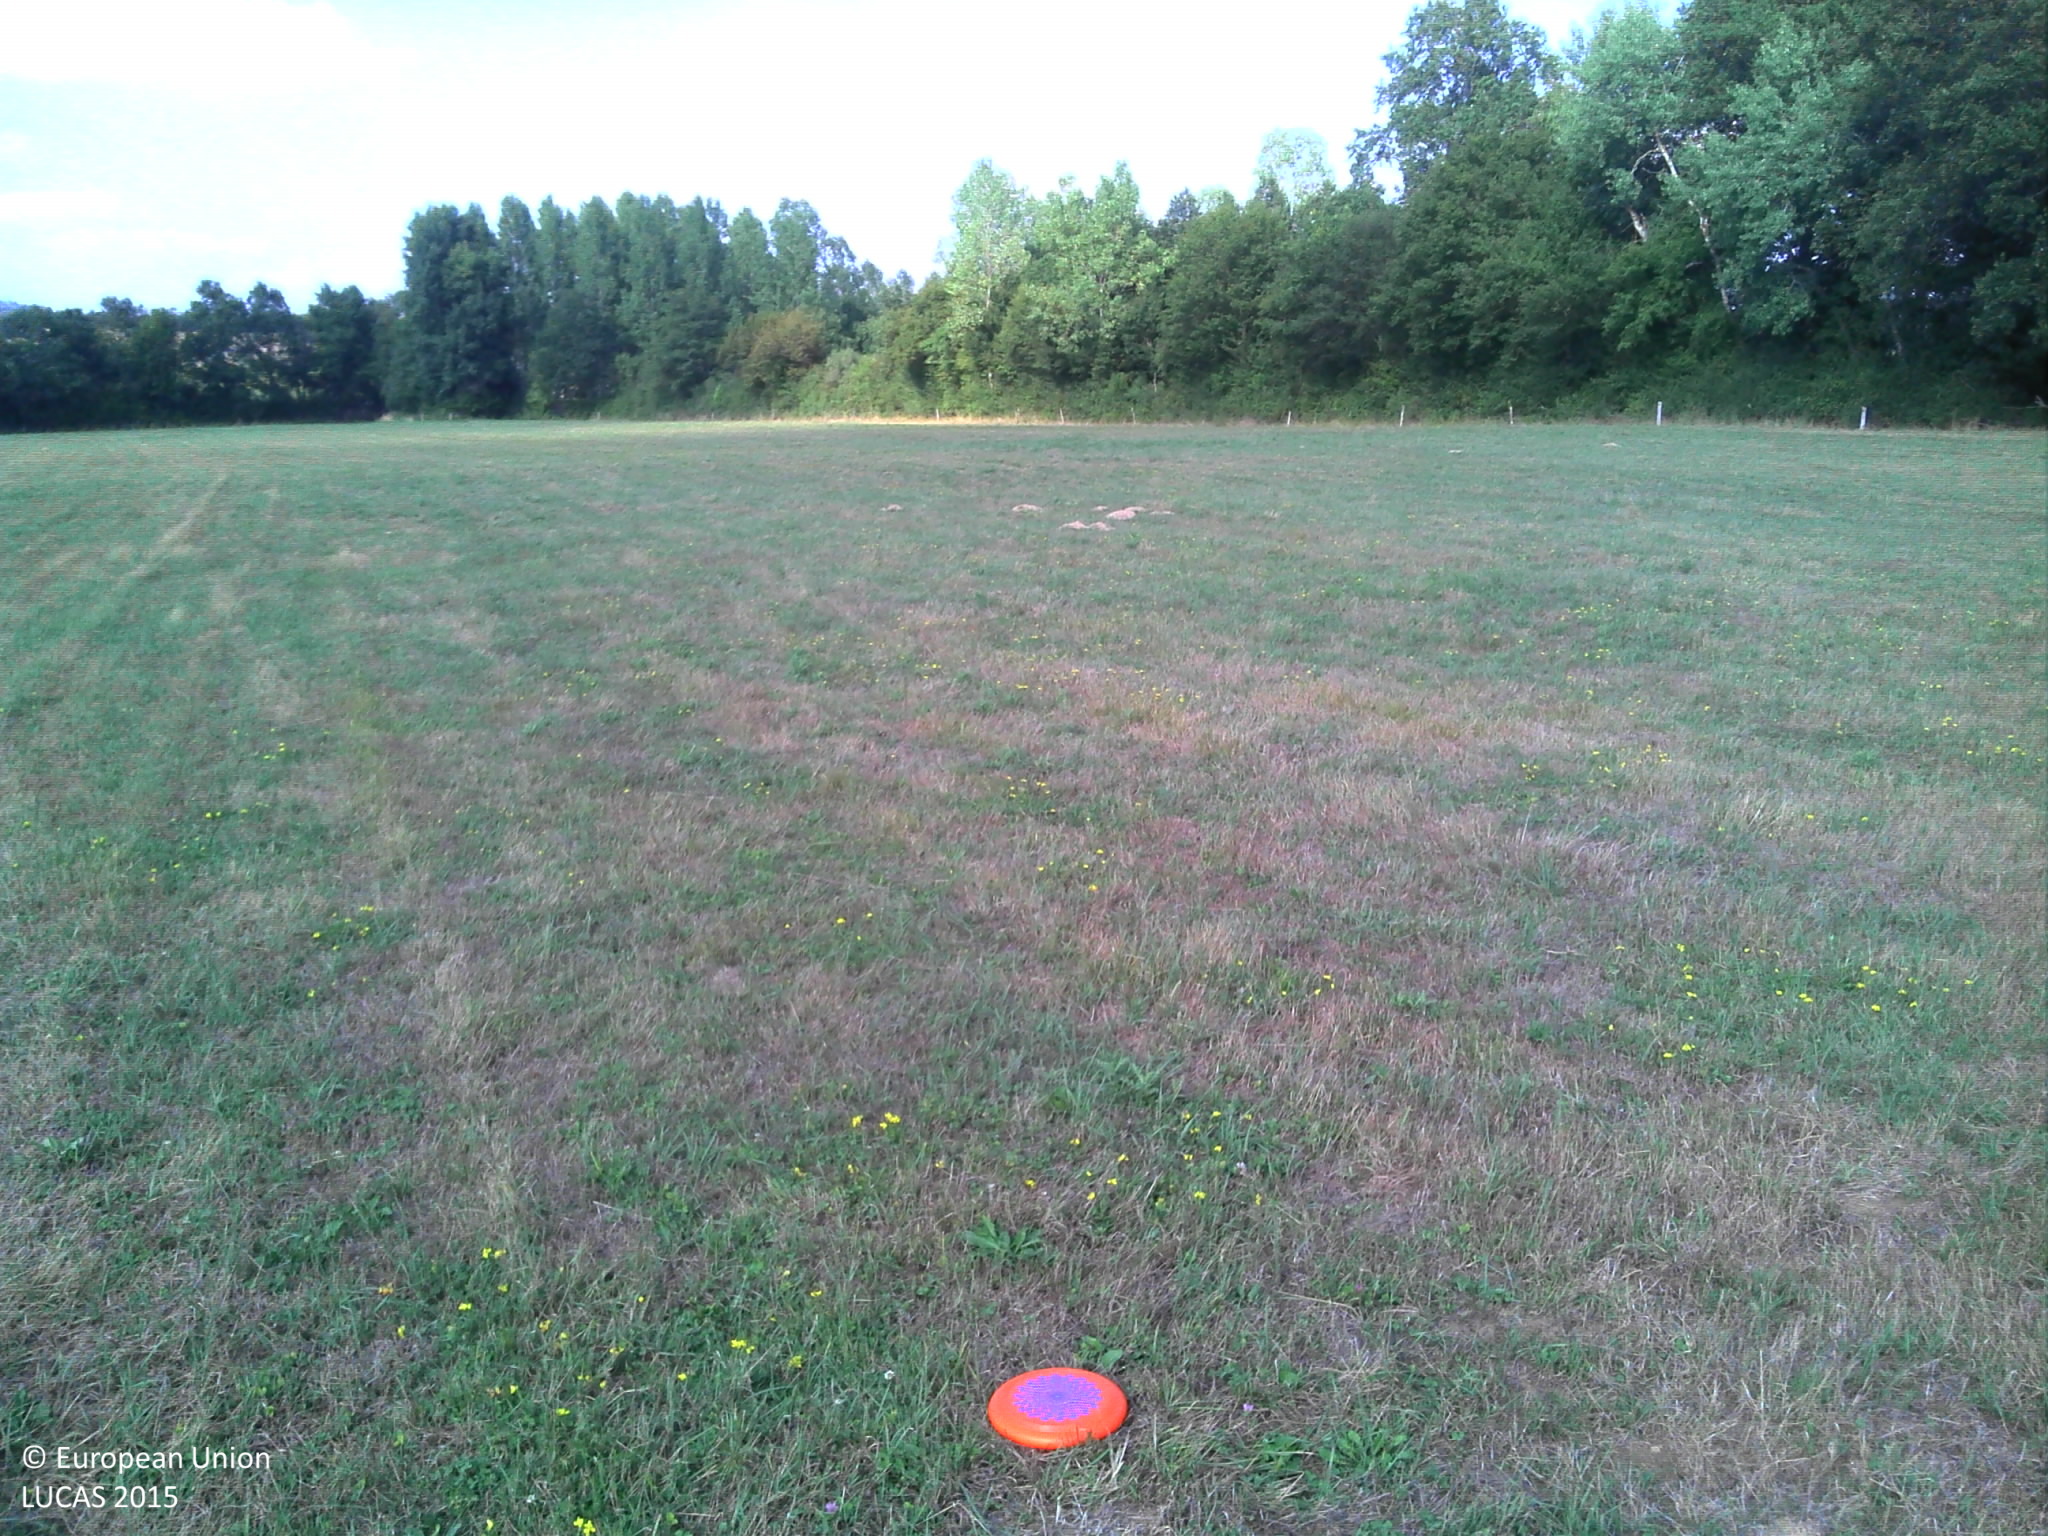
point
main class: Grassland
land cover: Grassland without tree/shrub cover
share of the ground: > 75 %
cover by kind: herbaceous plants 100 %
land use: Agriculture (excluding fallow land and kitchen gardens)
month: August
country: FR
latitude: 47.0159
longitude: 4.3827
